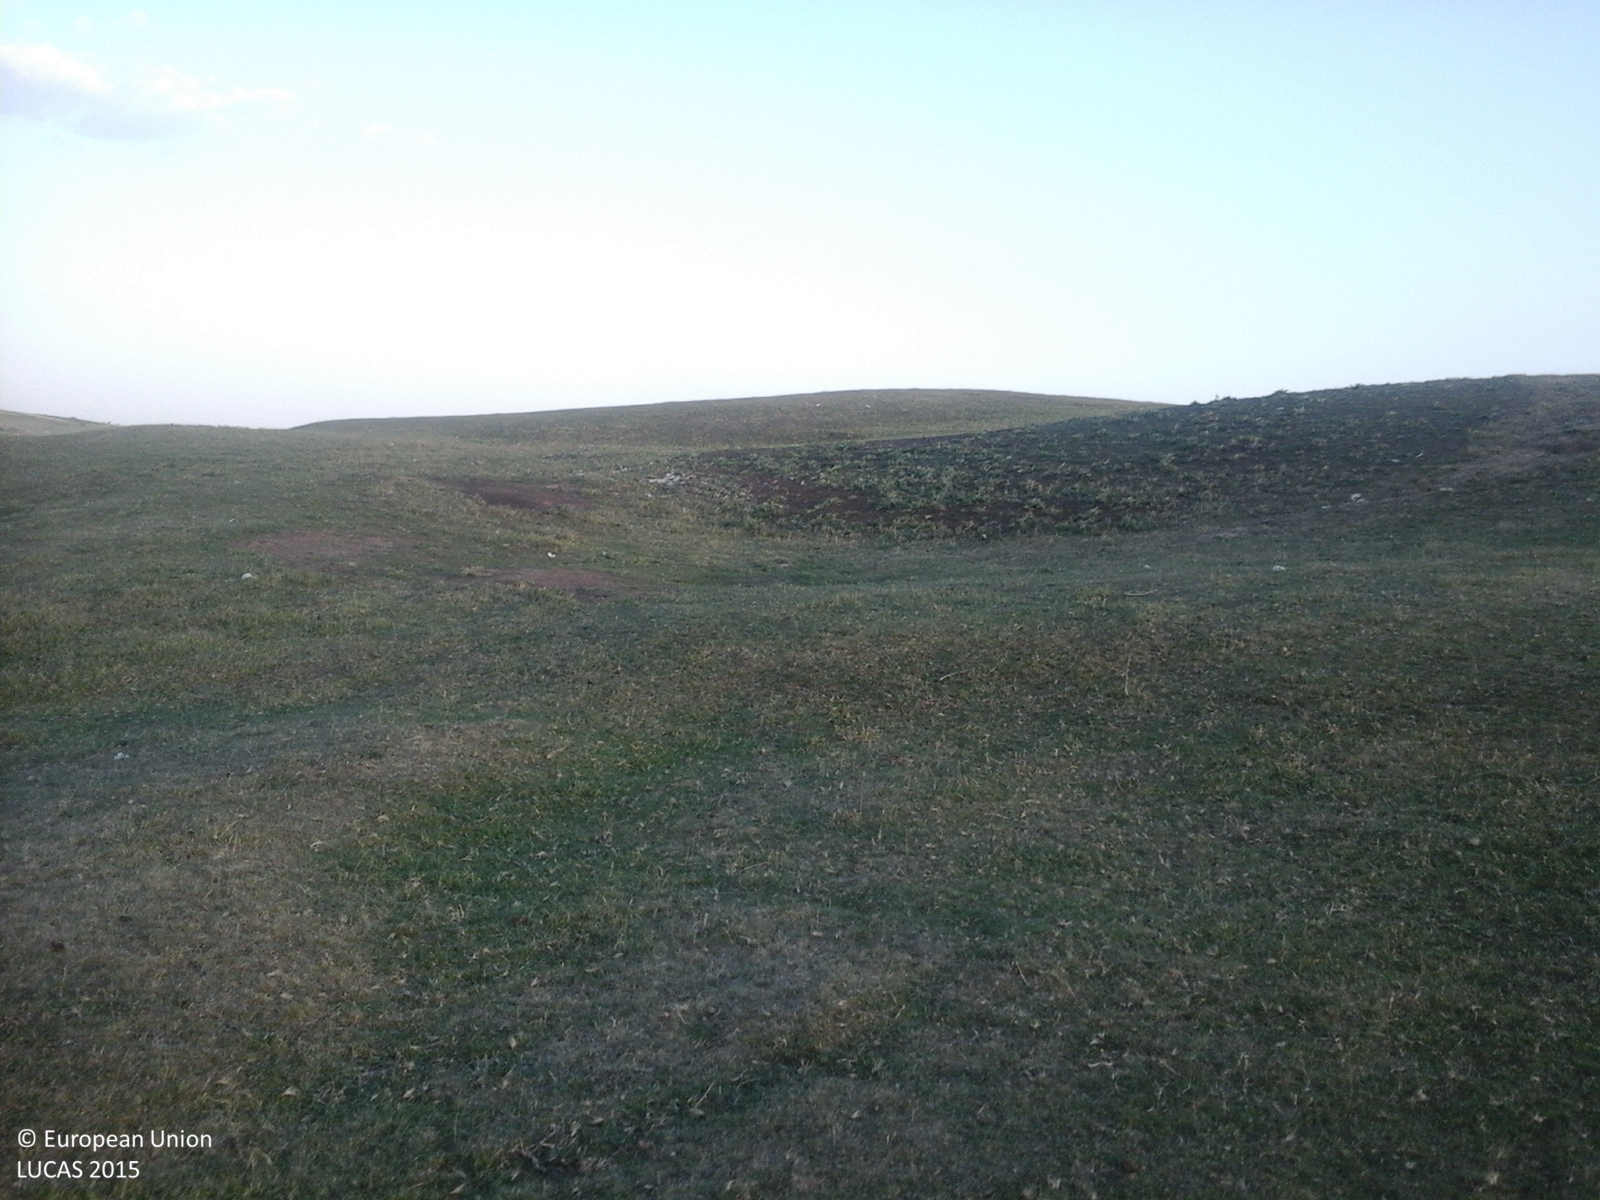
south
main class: Grassland
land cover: Grassland without tree/shrub cover
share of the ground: > 75 %
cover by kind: herbaceous plants 100 %
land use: Agriculture (excluding fallow land and kitchen gardens)
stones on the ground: < 10 %
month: June
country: RO
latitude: 46.9467
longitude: 27.3331
